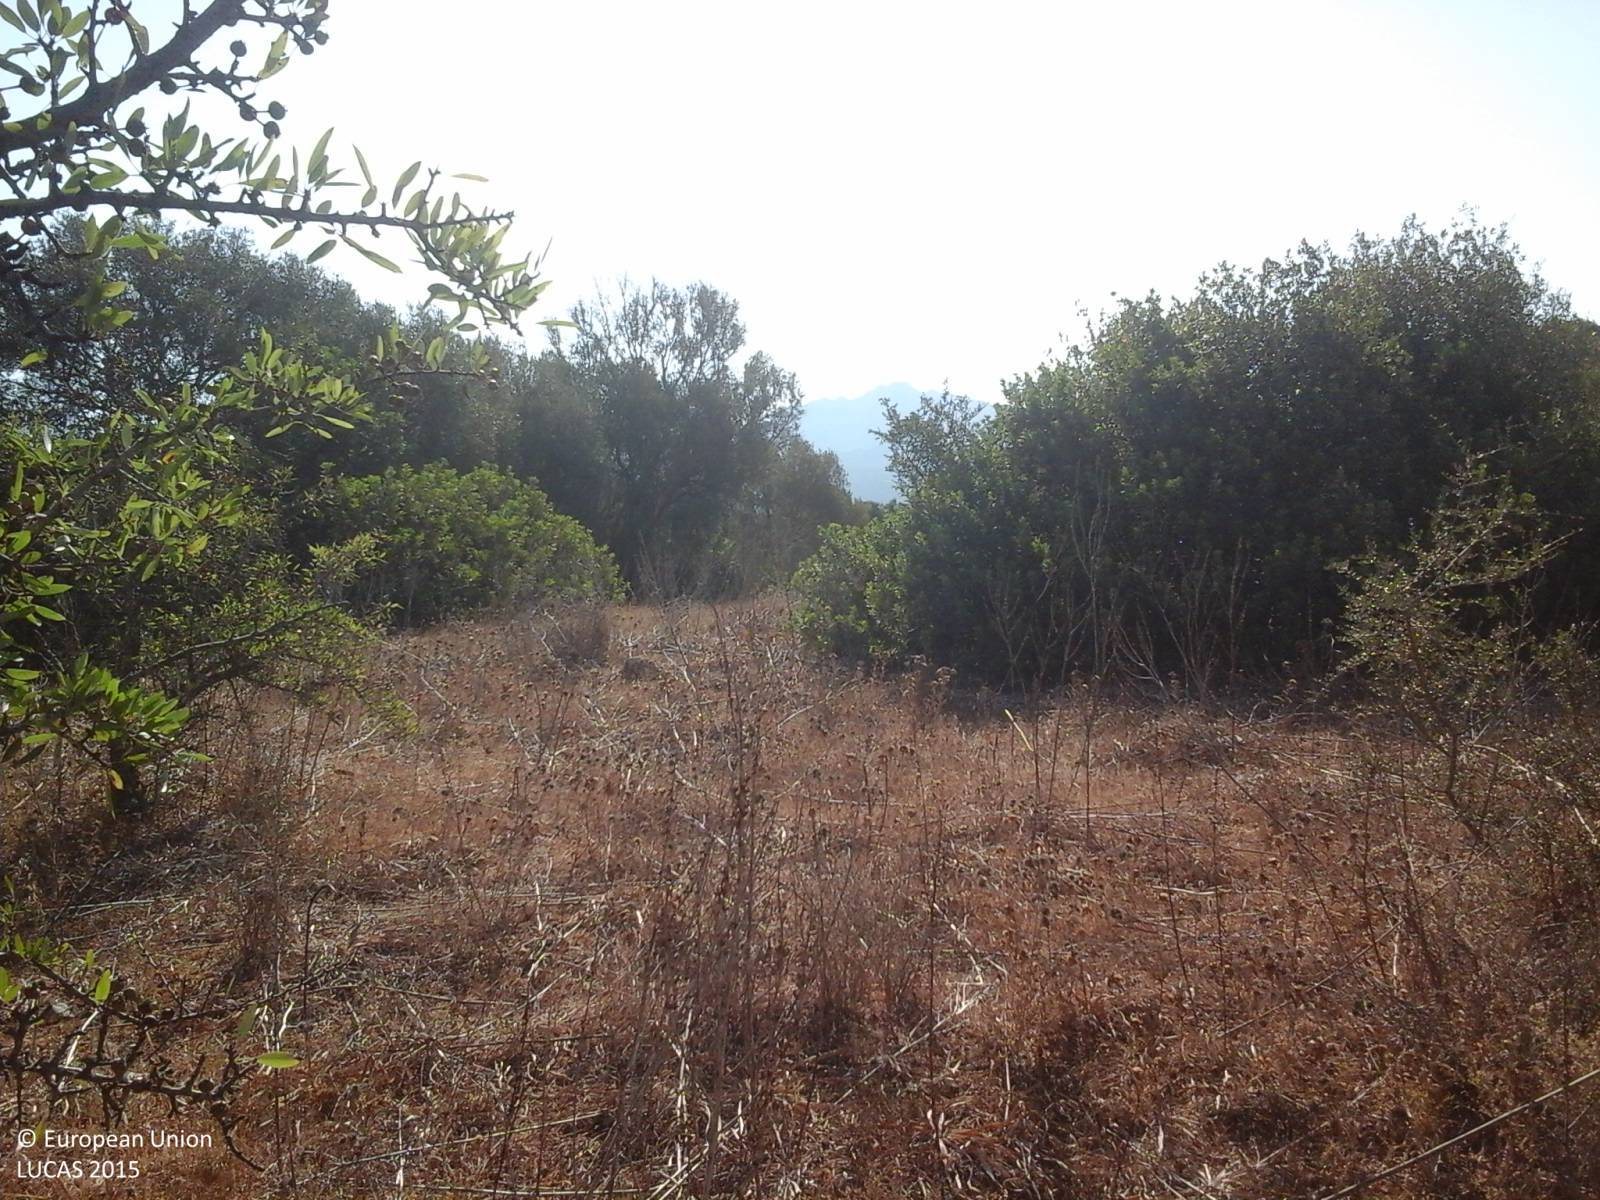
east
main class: Shrubland
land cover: Shrubland with sparse tree cover
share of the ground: > 75 %
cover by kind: shrubs 90 %, broadleaved forest trees 5 %, unconsolidated bare surface 5 %
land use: Semi-natural and natural areas not in use
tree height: > 5 m
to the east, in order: Shrubland with sparse tree cover; Fences; Dry stone walls; Shrubland with sparse tree cover
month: September
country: IT
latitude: 41.0436
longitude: 9.3961
